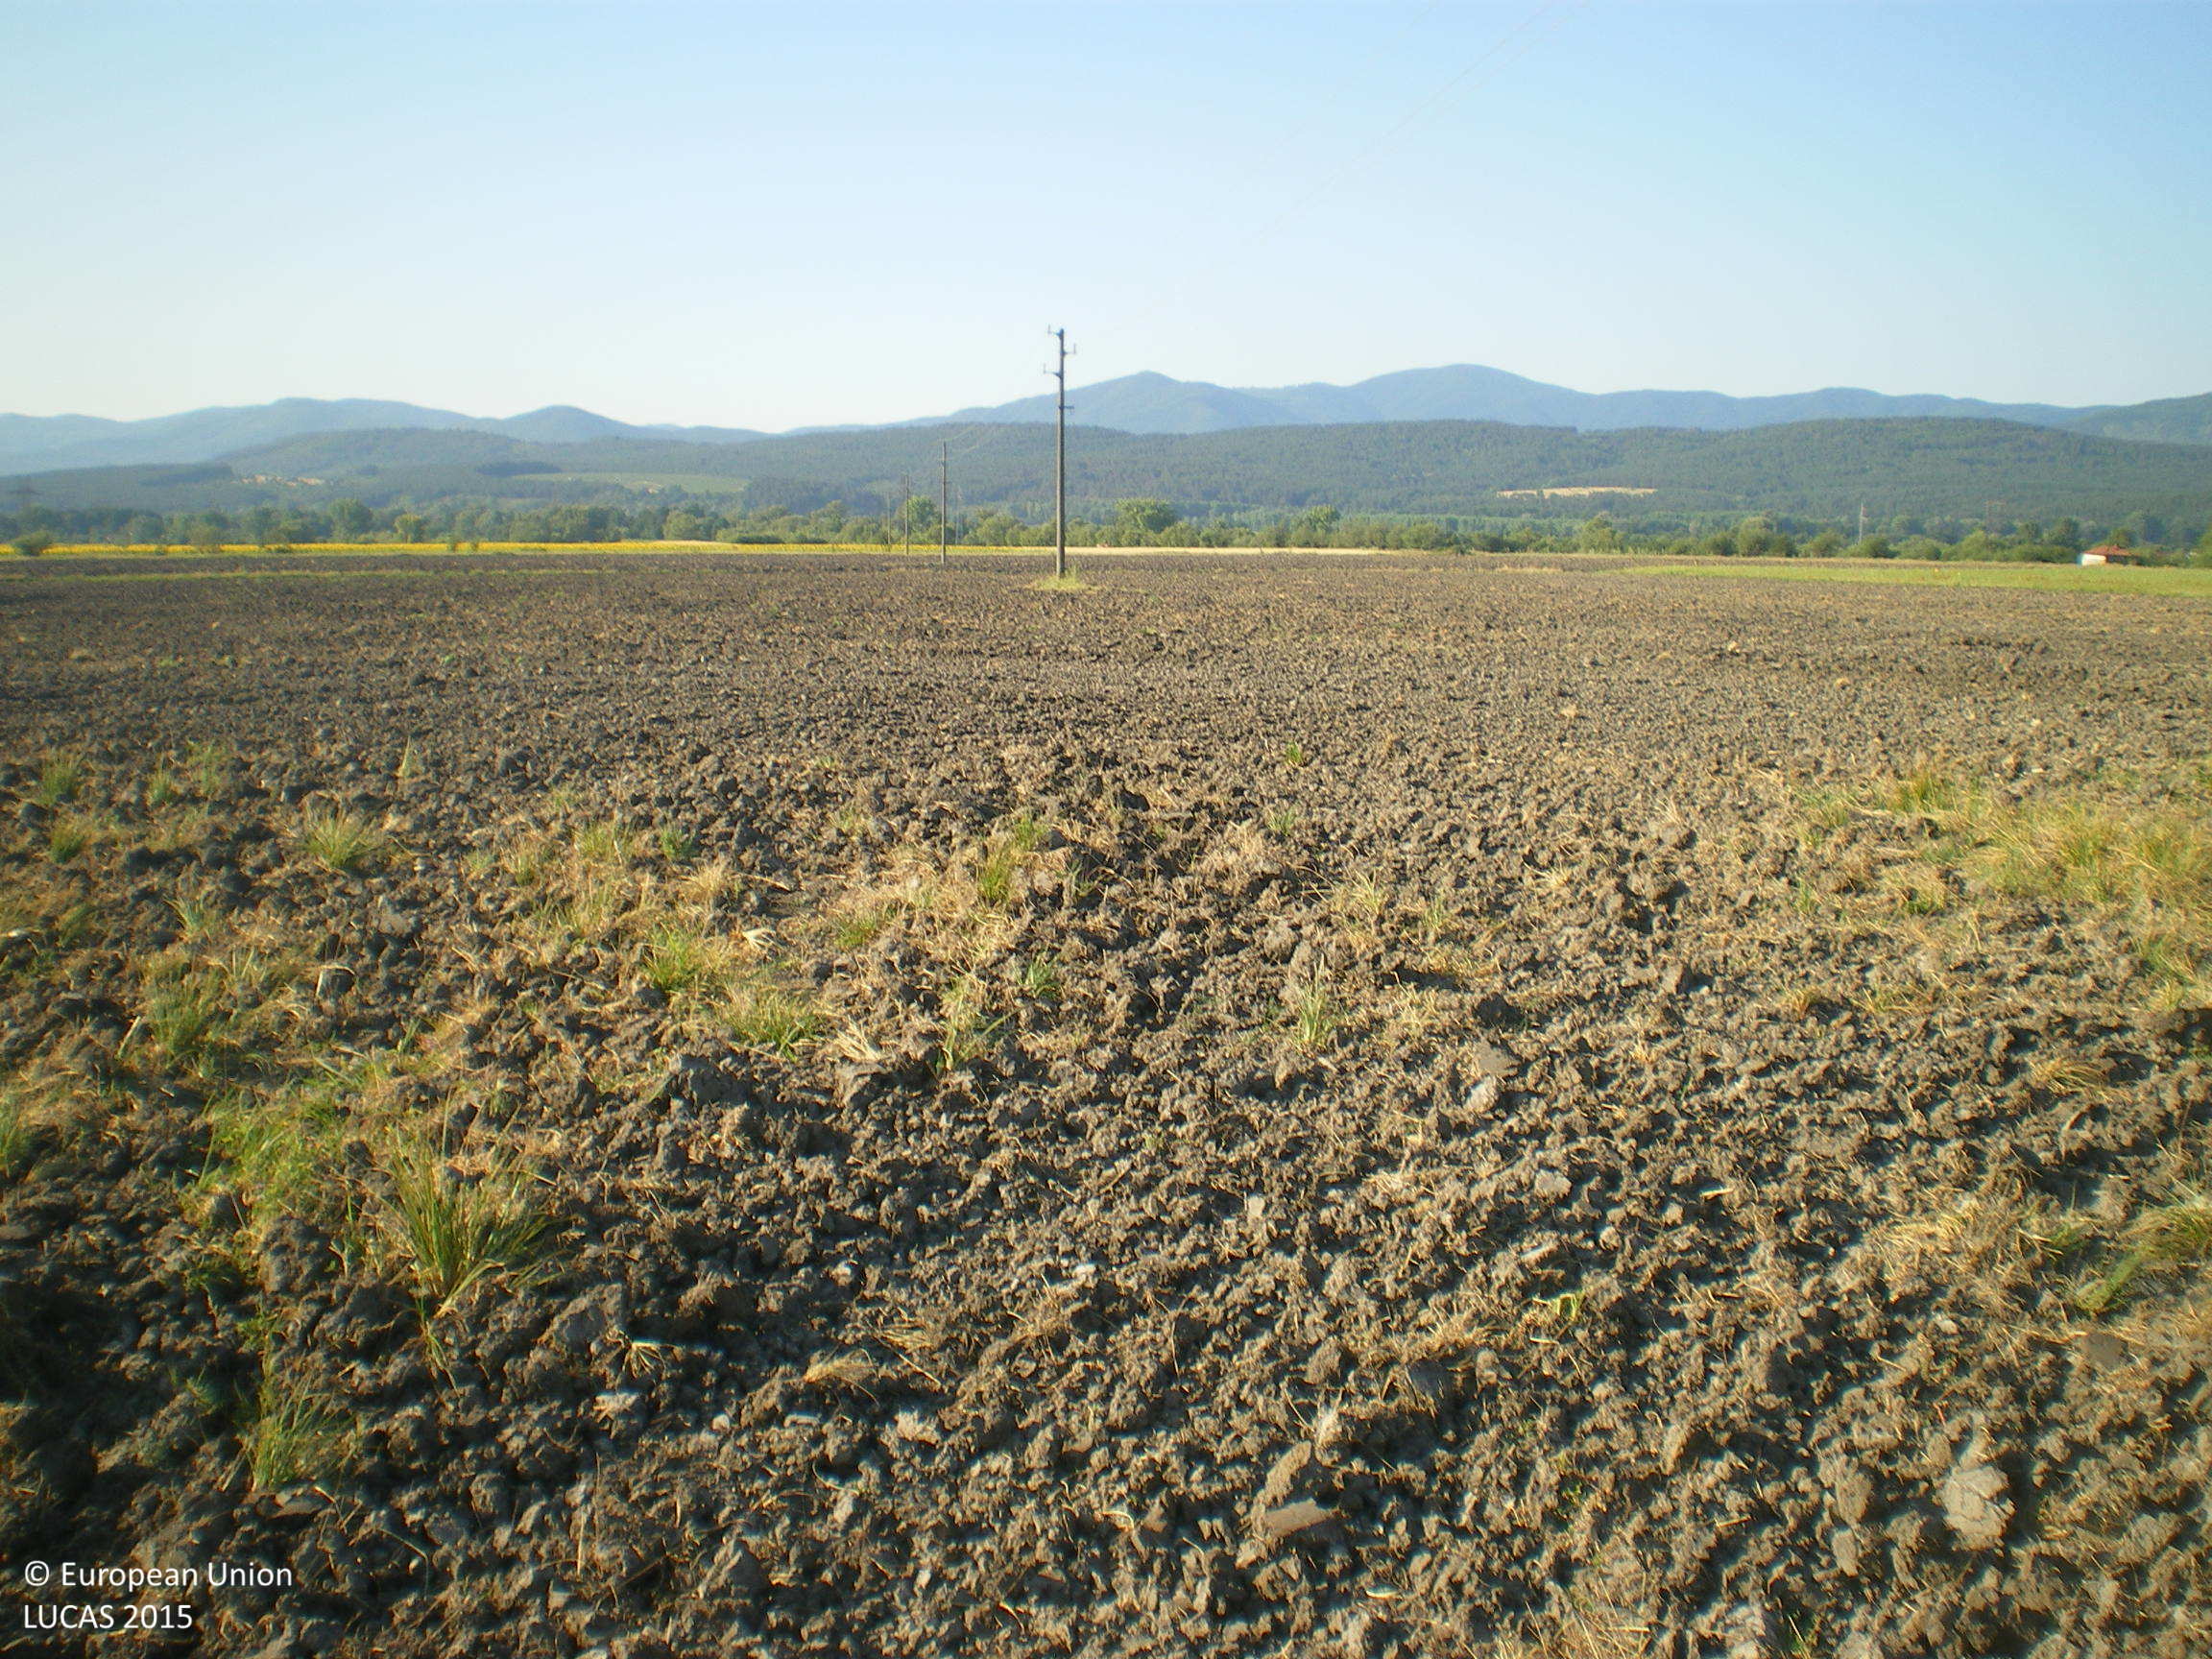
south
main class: Grassland
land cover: Spontaneously vegetated surfaces
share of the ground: 50 - 75 %
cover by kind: herbaceous plants 50 %, unconsolidated bare surface 50 %
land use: Agriculture (excluding fallow land and kitchen gardens)
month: July
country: BG
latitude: 42.6223
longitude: 25.1712
